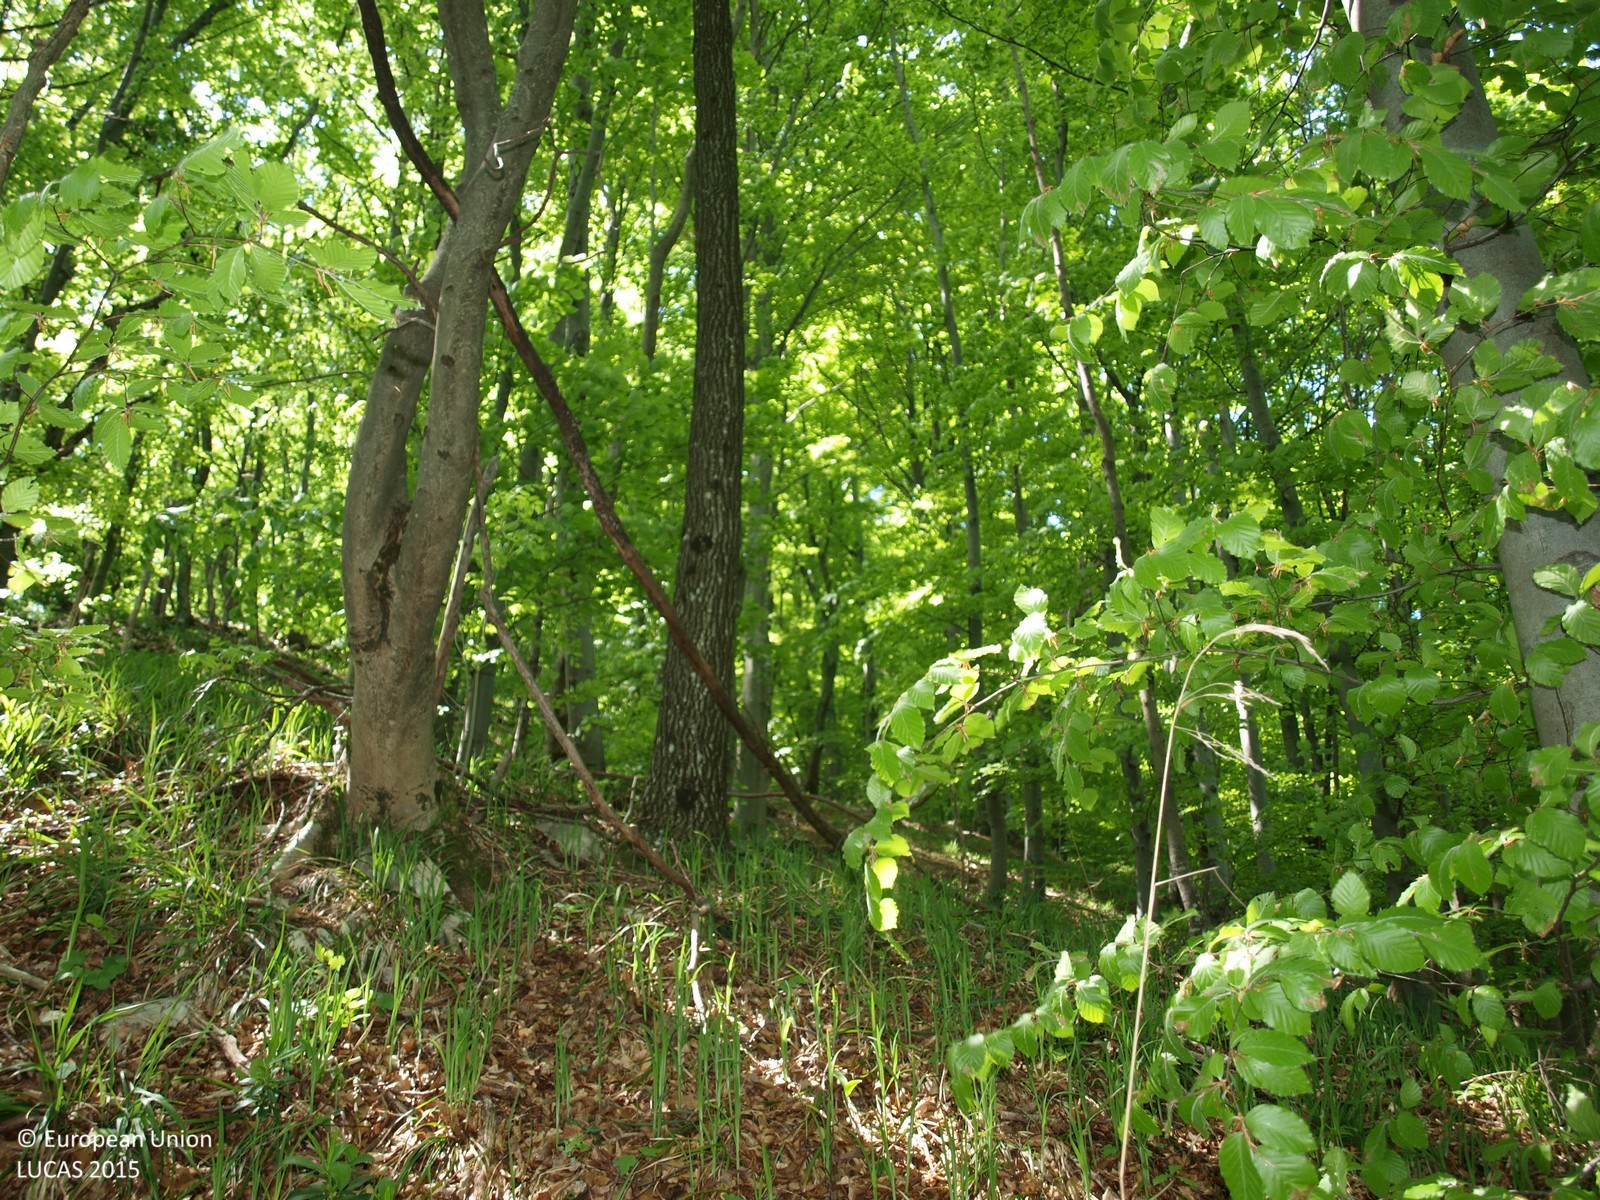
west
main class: Woodland
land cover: Broadleaved woodland
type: beech forest
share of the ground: > 75 %
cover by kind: broadleaved forest trees 100 %
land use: Forestry
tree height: > 5 m
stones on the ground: < 10 %
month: April
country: HR
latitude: 46.2712
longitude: 16.0331
